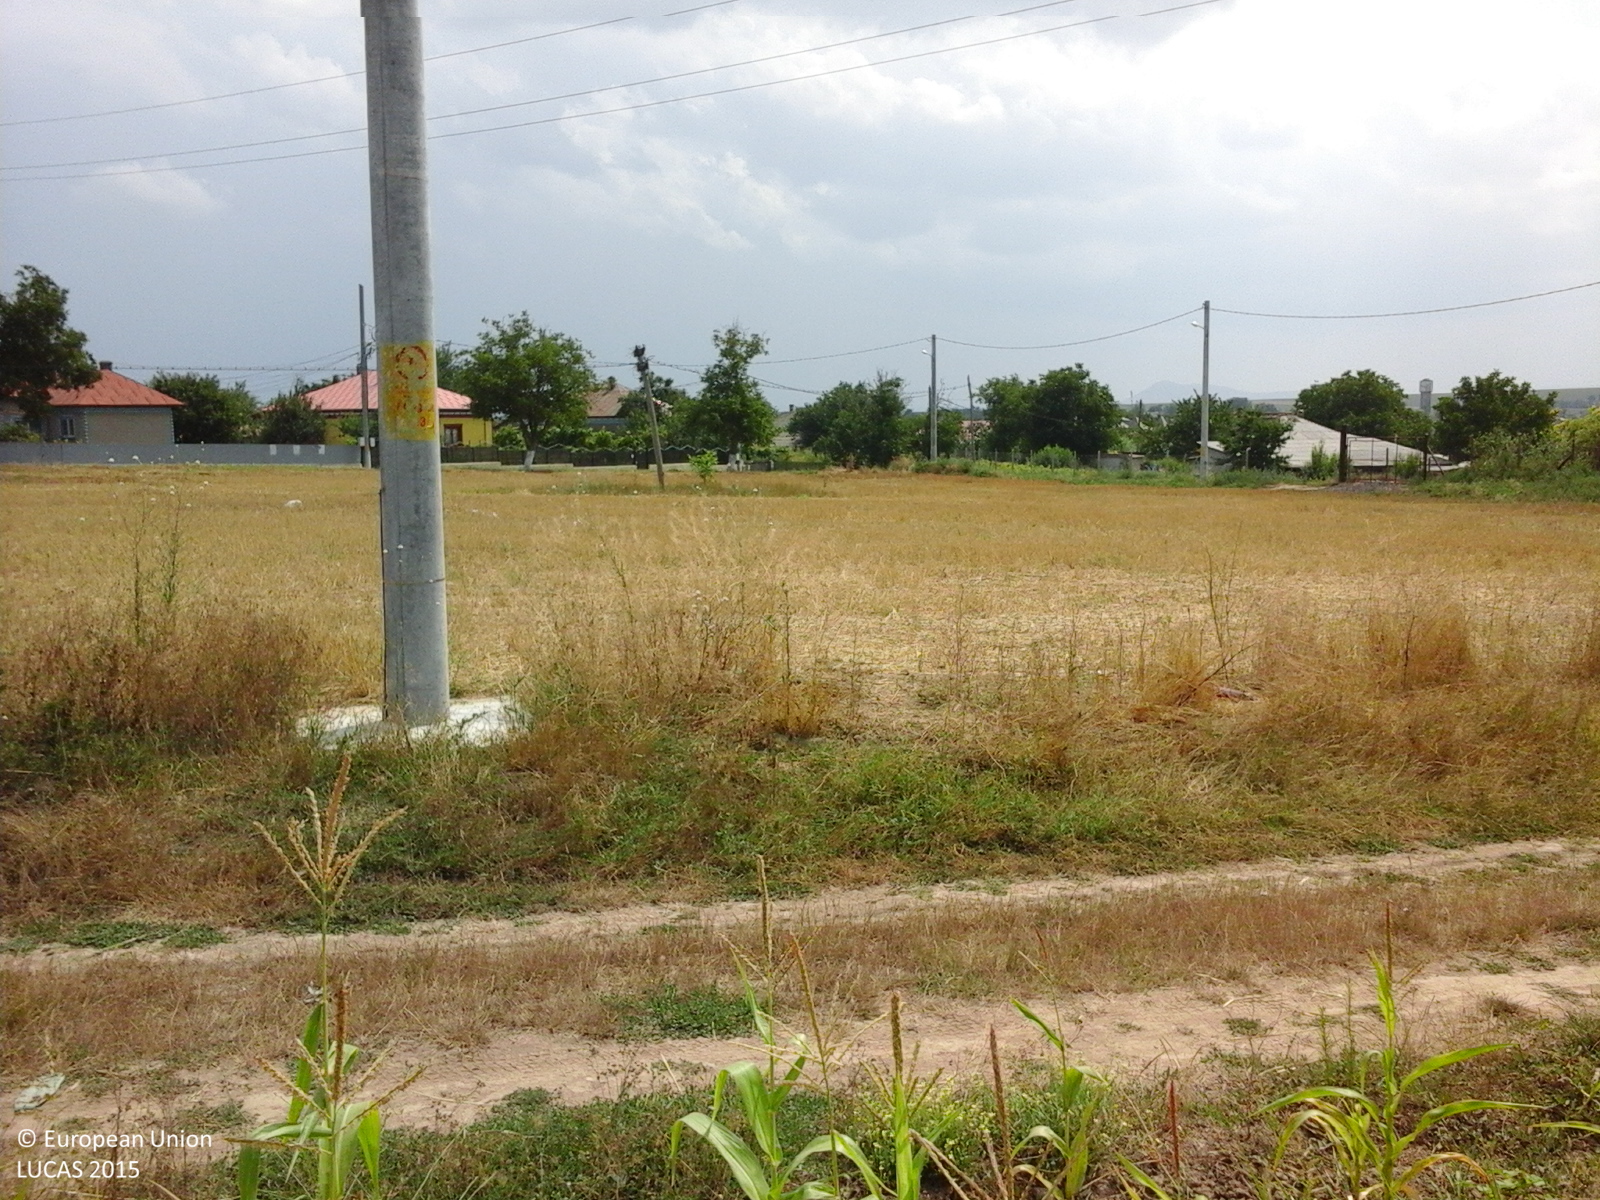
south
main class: Cropland
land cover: Maize
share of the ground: > 75 %
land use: Agriculture (excluding fallow land and kitchen gardens)
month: July
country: RO
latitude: 45.1021
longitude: 28.7301
